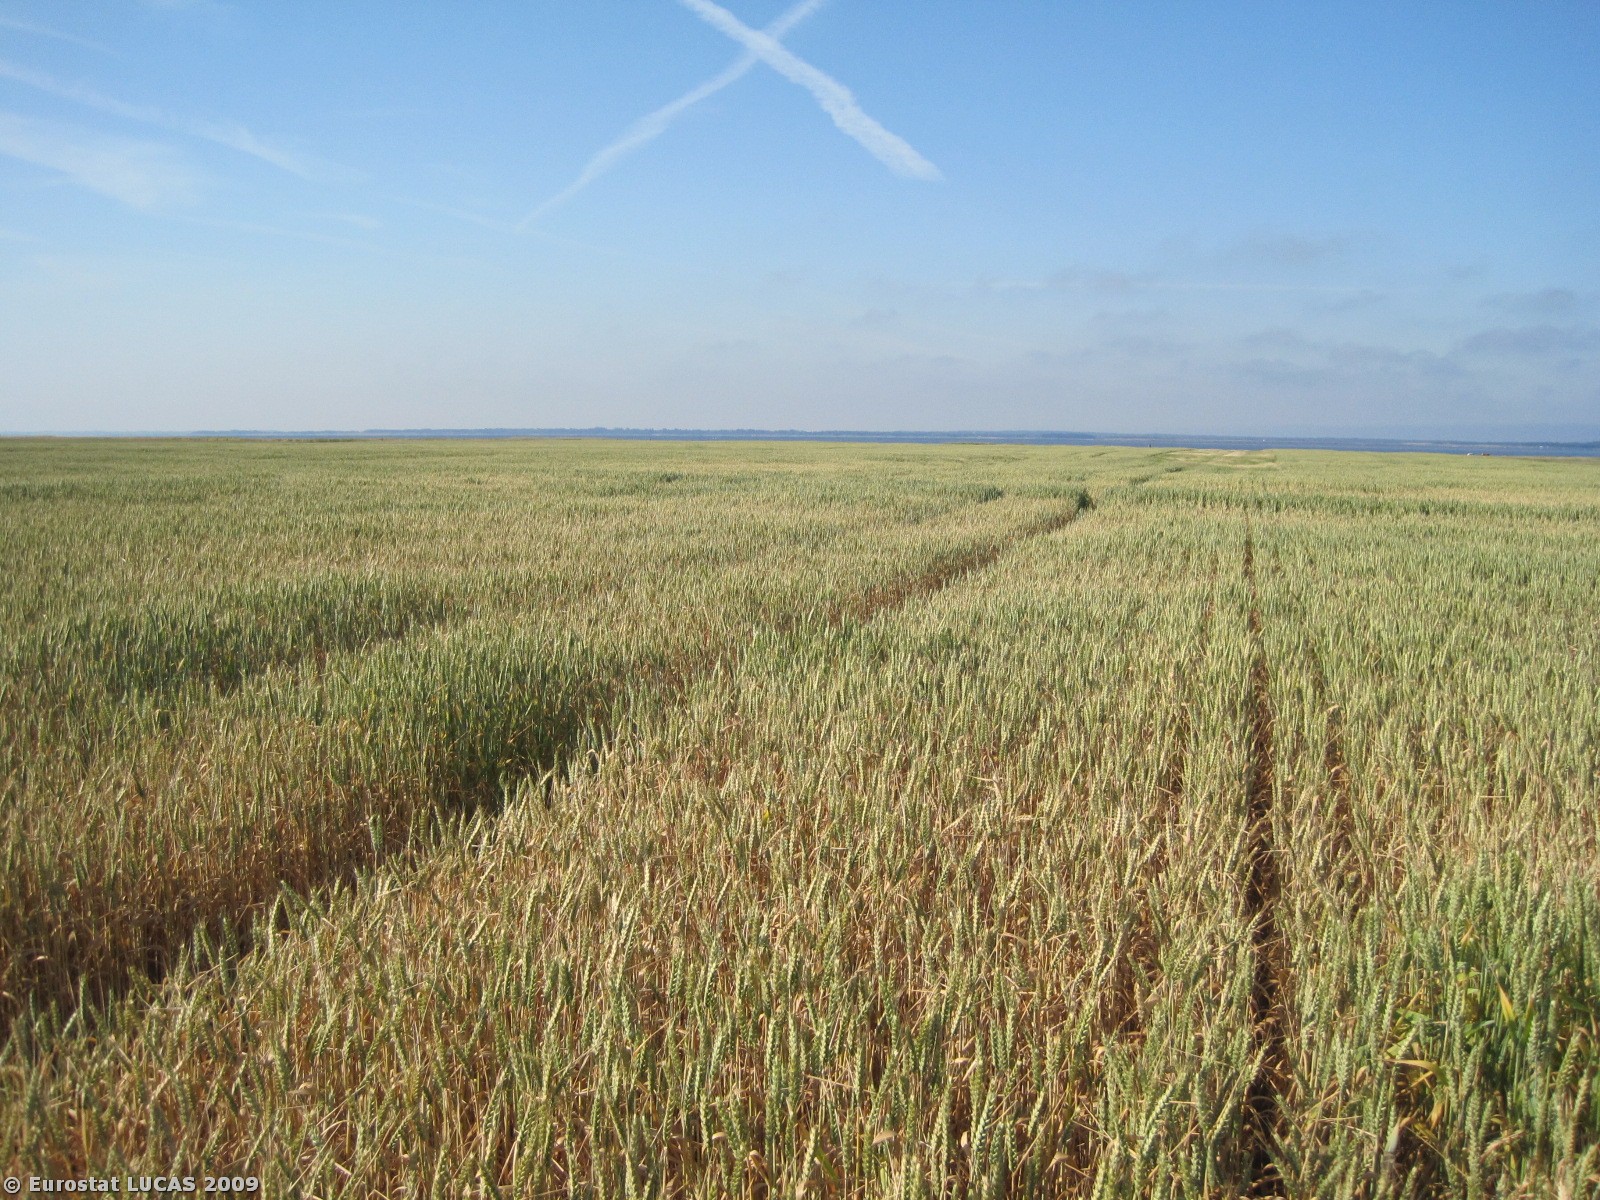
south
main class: Cropland
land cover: Common wheat
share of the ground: > 75 %
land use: Agriculture (excluding fallow land and kitchen gardens)
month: July
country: DK
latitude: 56.3730
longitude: 8.2048
